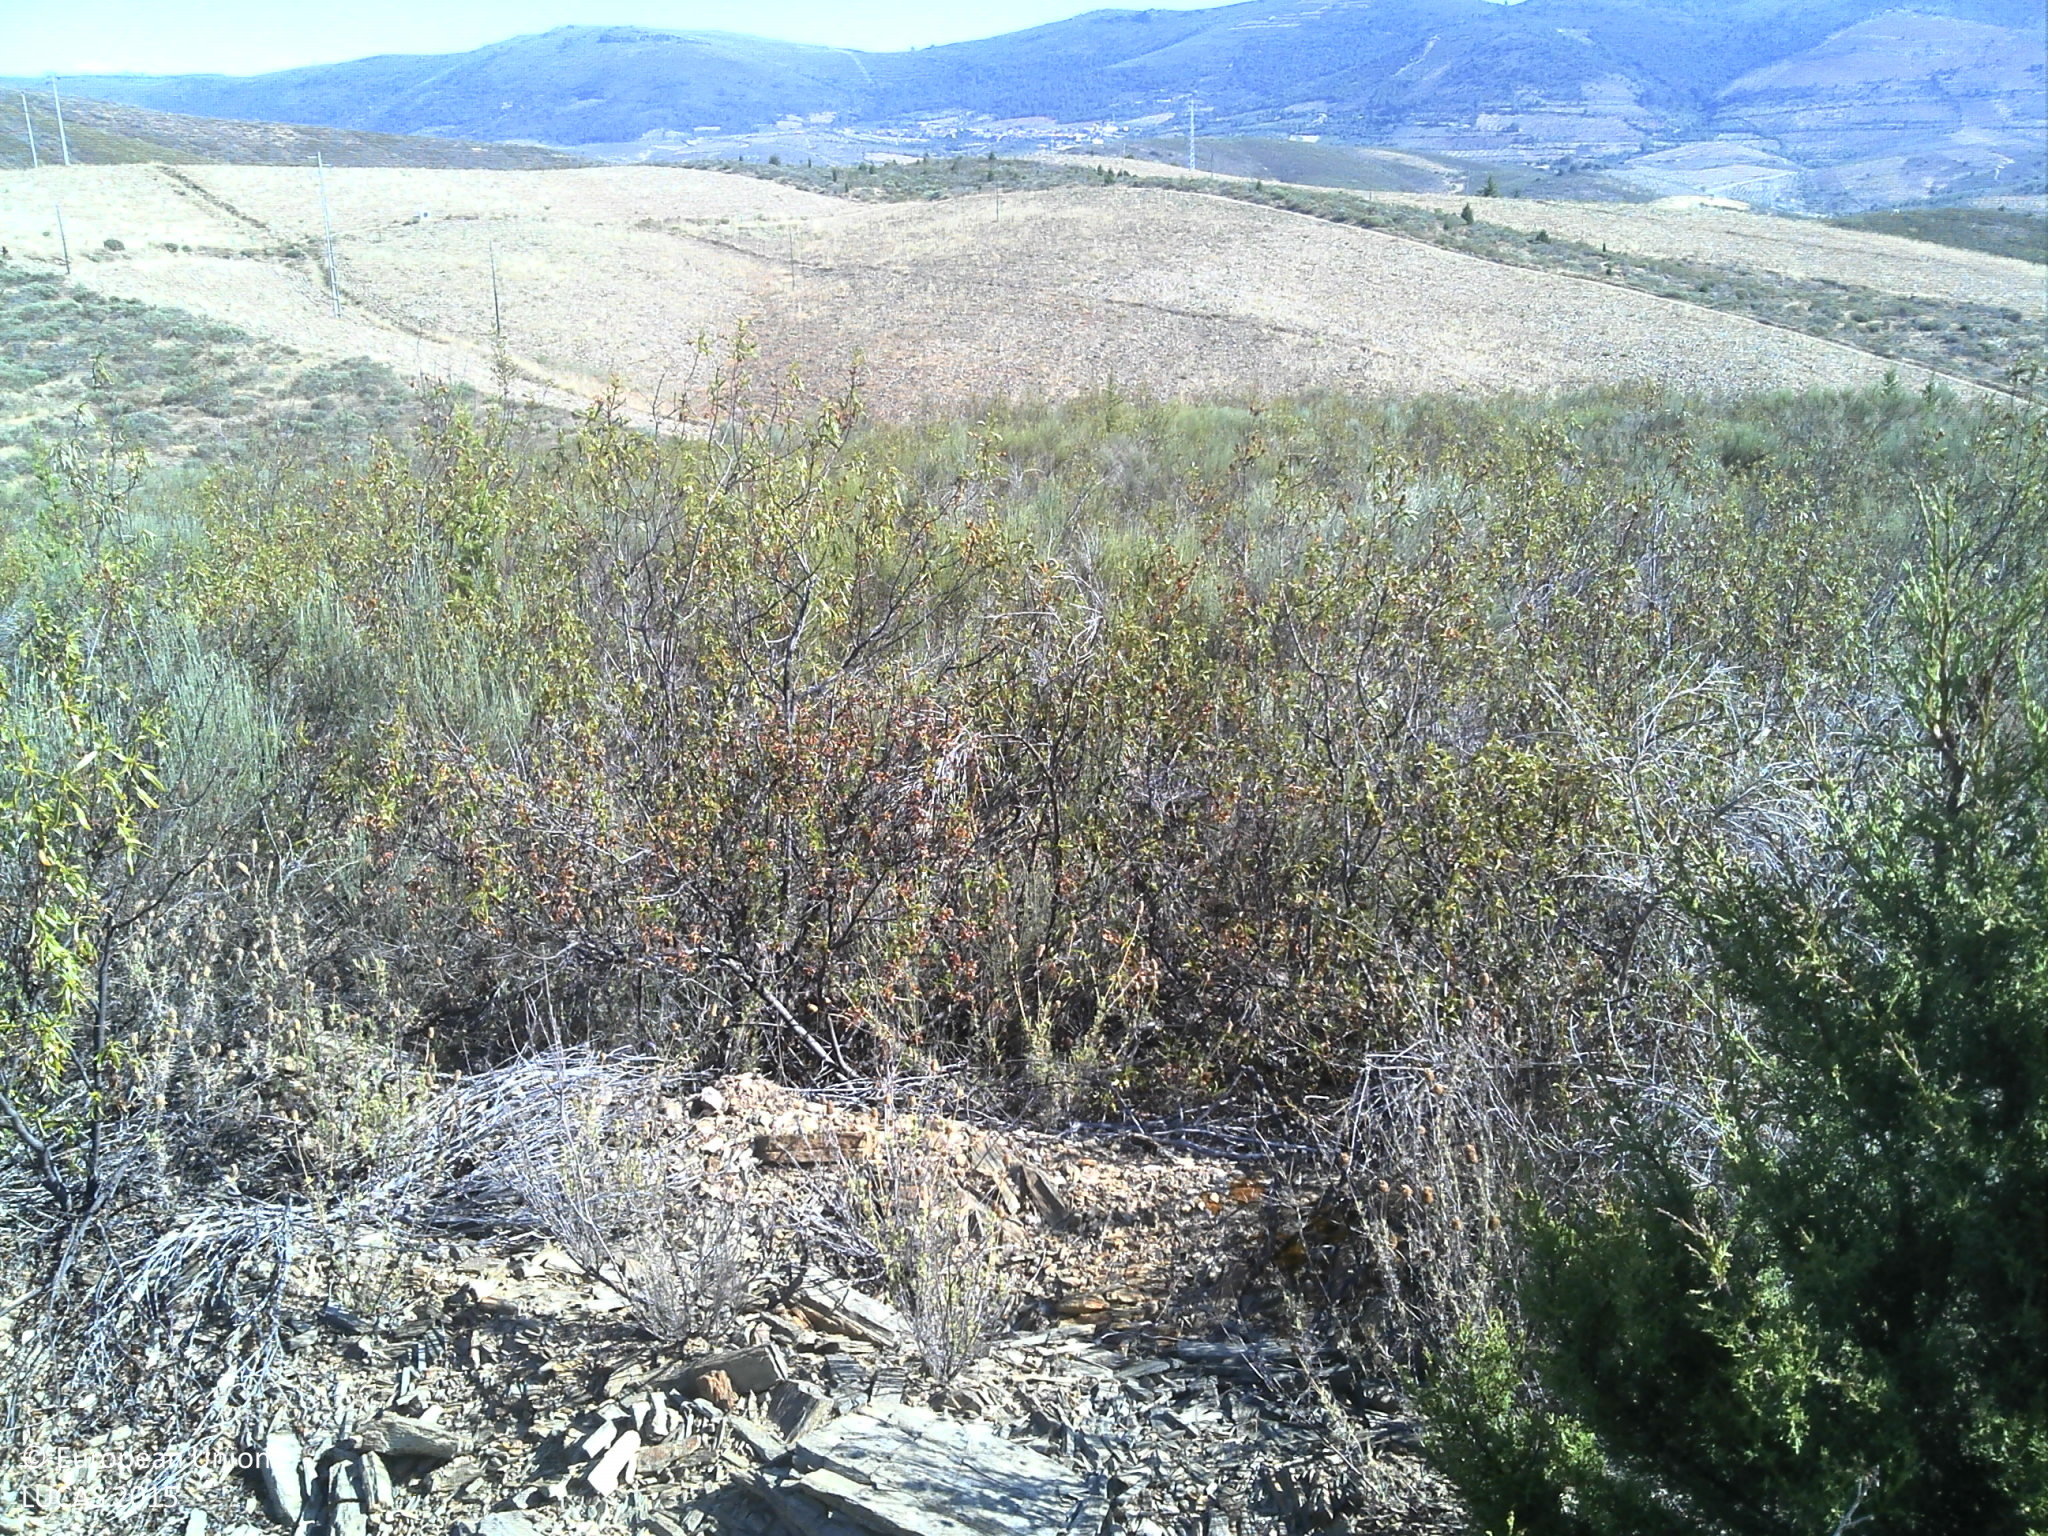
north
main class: Shrubland
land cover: Shrubland with sparse tree cover
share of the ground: > 75 %
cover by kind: shrubs 95 %, coniferous forest trees 5 %
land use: Abandoned areas
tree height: < 5 m
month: July
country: PT
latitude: 41.0936
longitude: -7.0021
